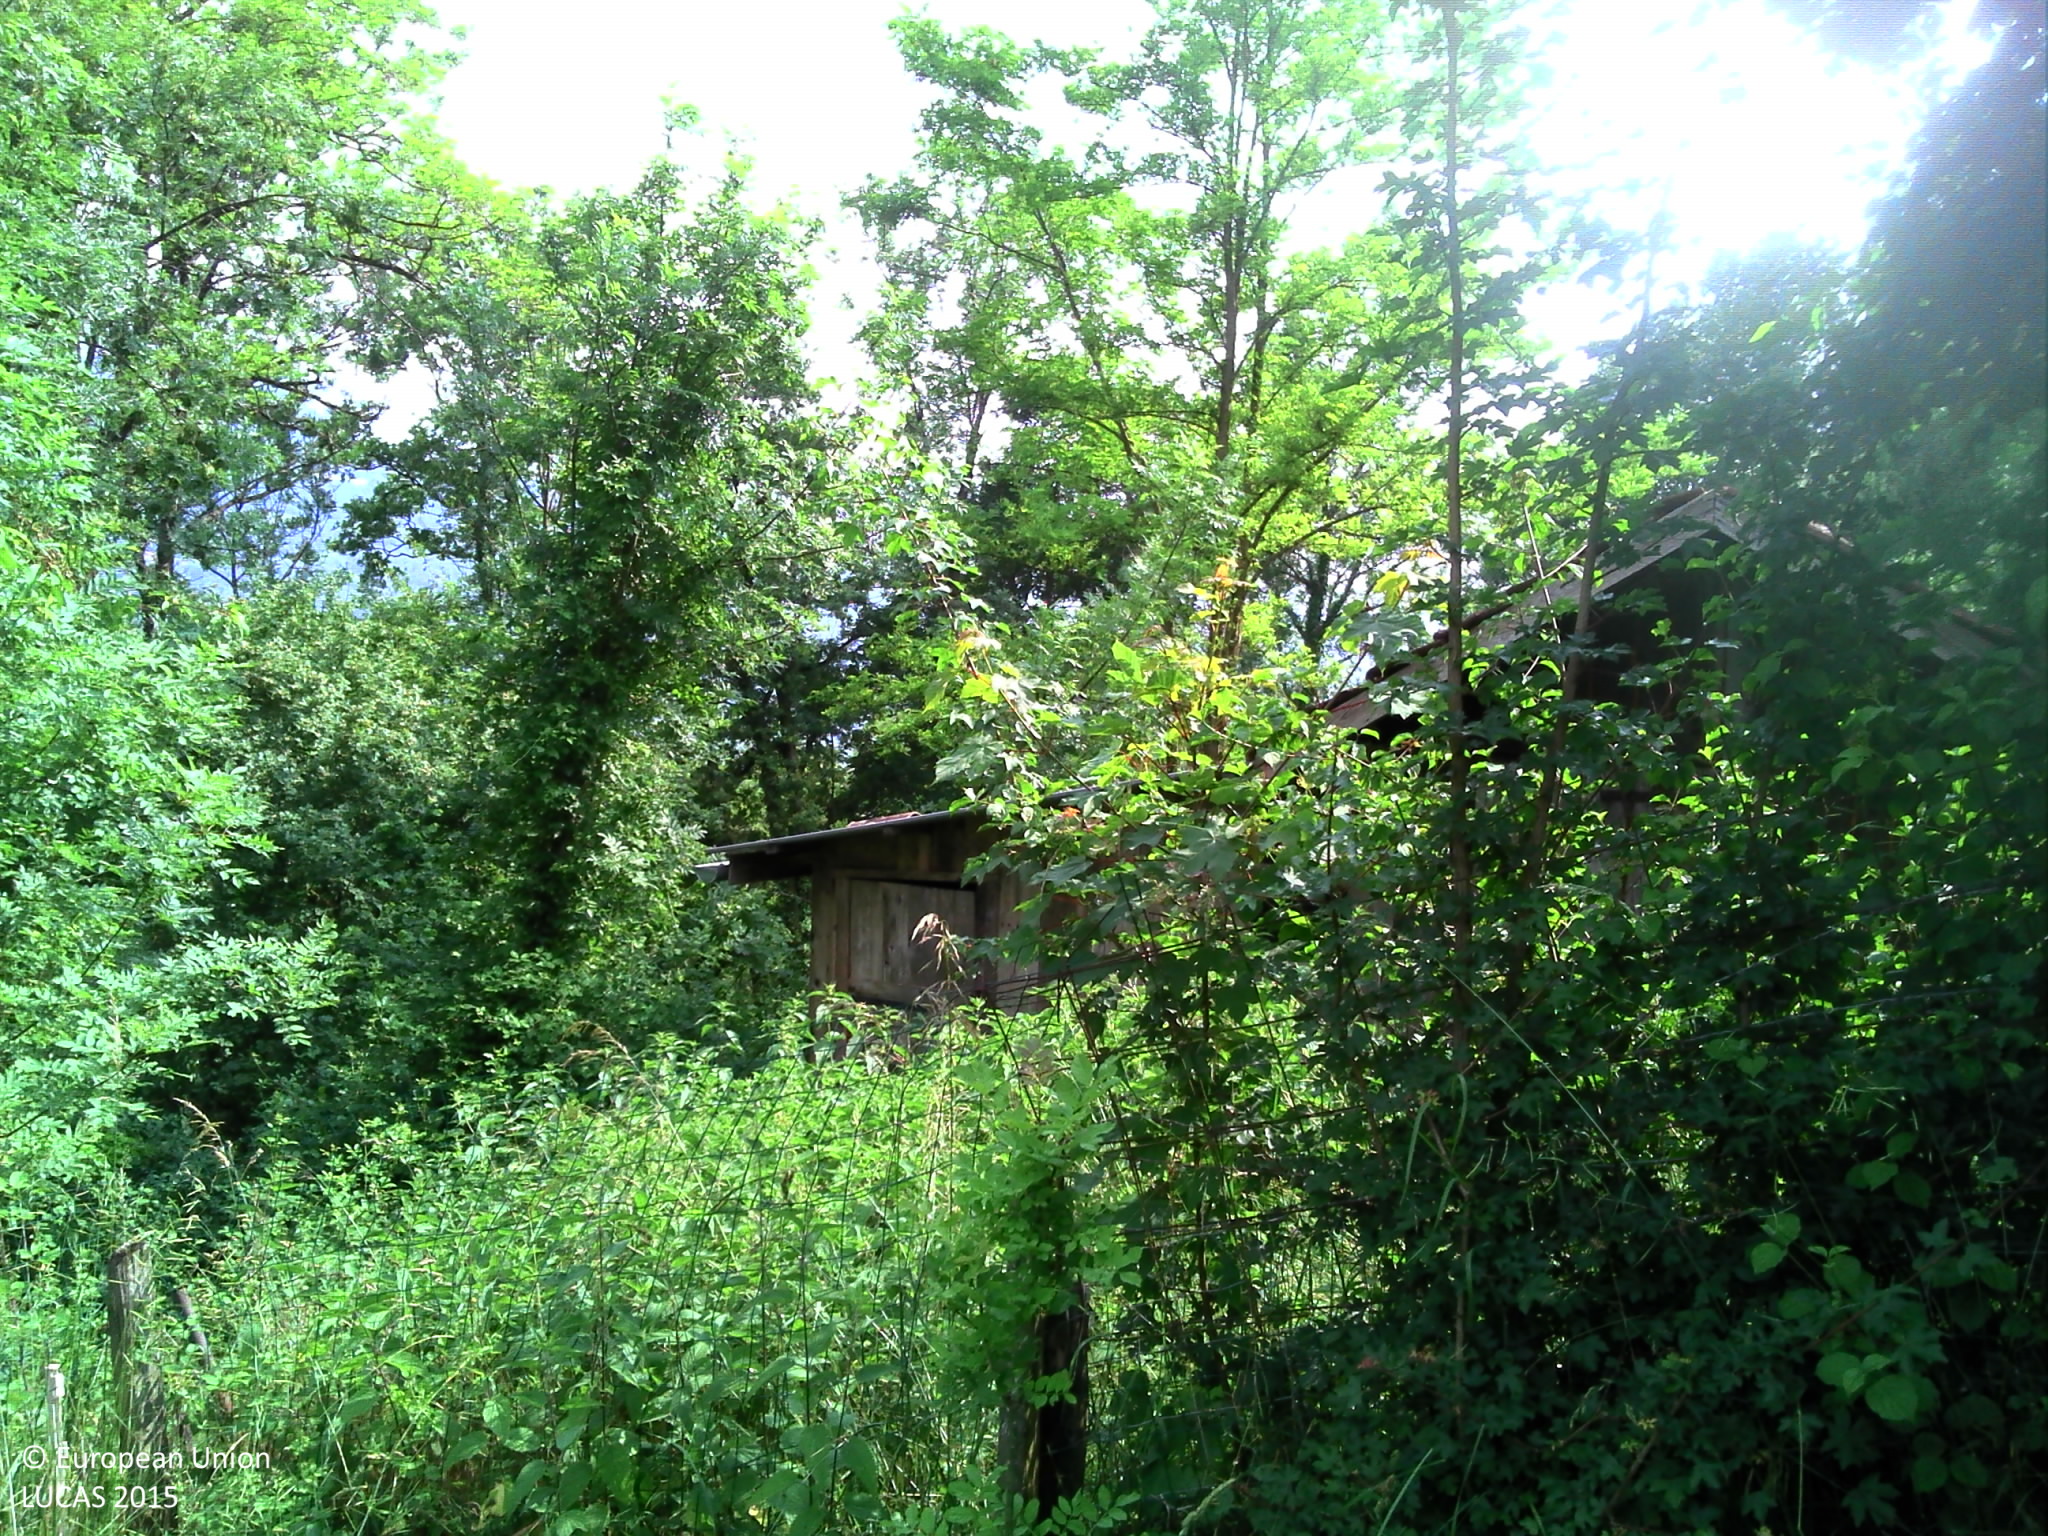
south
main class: Grassland
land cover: Spontaneously vegetated surfaces
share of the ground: > 75 %
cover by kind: herbaceous plants 95 %, shrubs 5 %
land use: Abandoned areas
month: June
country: FR
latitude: 45.5065
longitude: 6.1521
